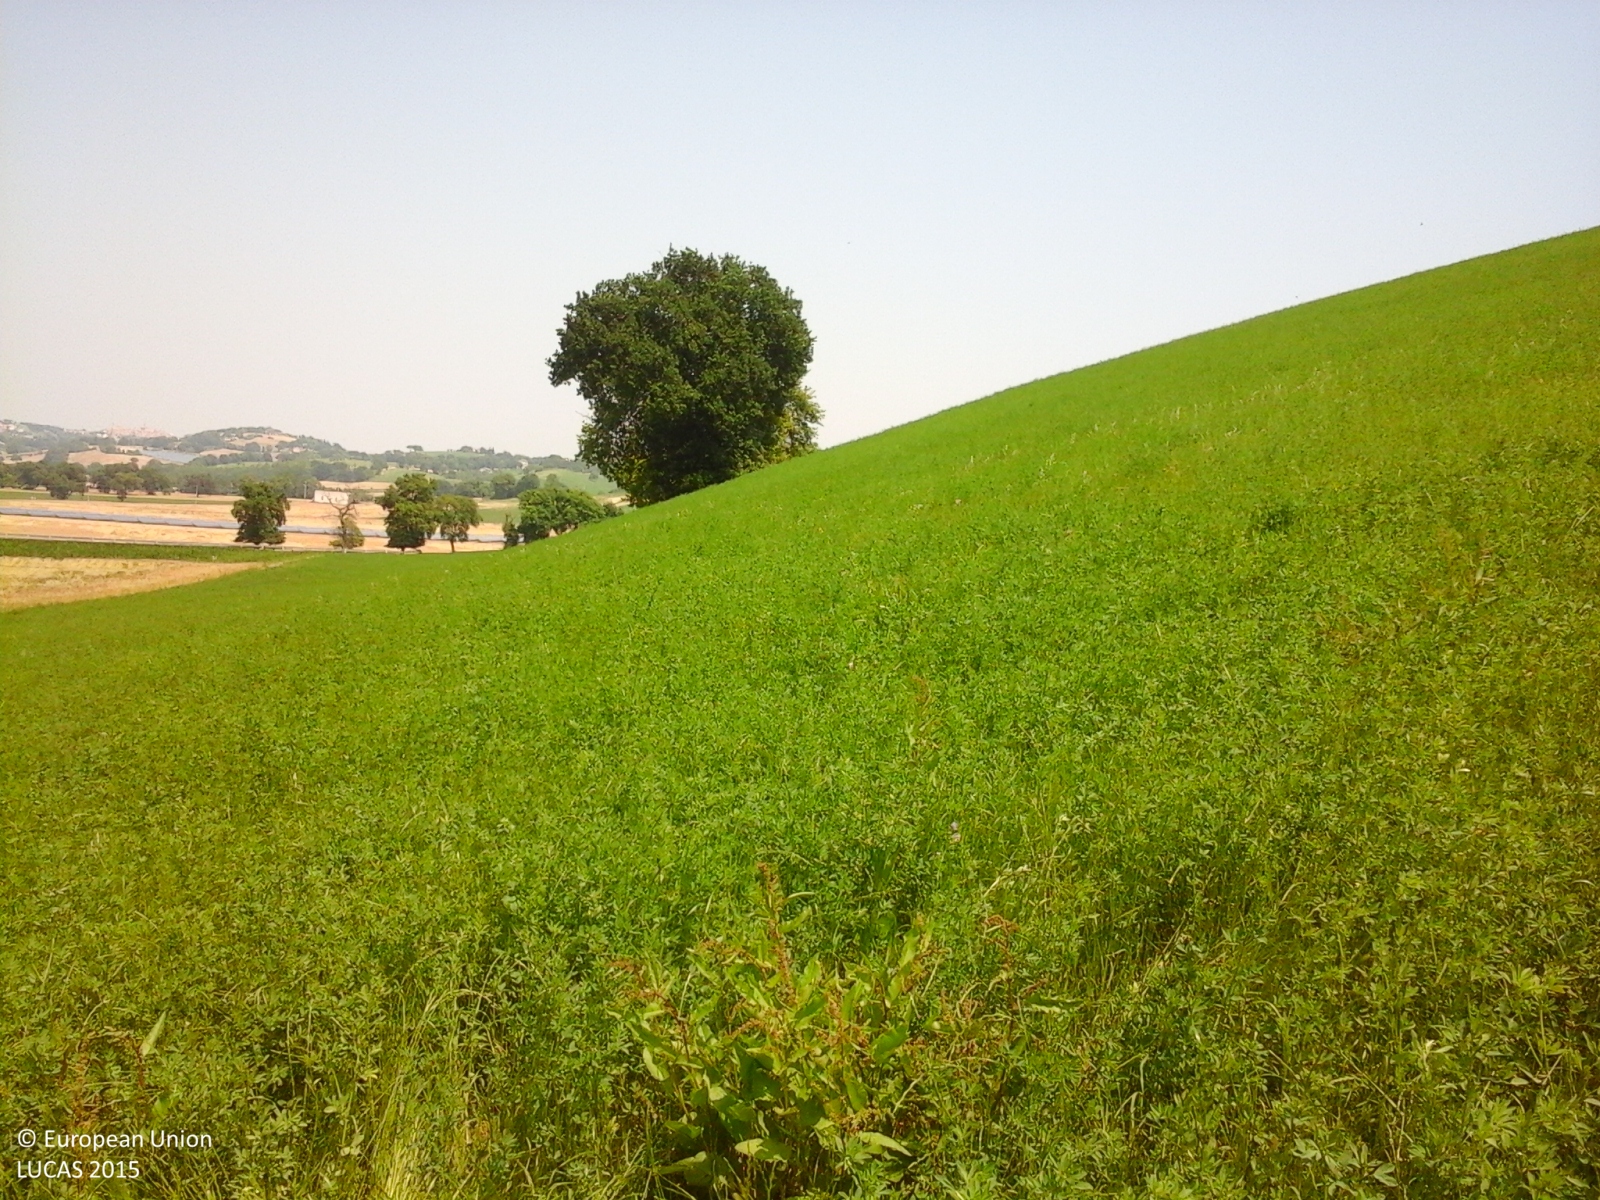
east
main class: Cropland
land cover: Lucerne
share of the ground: > 75 %
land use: Agriculture (excluding fallow land and kitchen gardens)
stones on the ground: > 50 %
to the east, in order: Lucerne
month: June
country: IT
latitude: 43.2277
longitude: 13.4507
